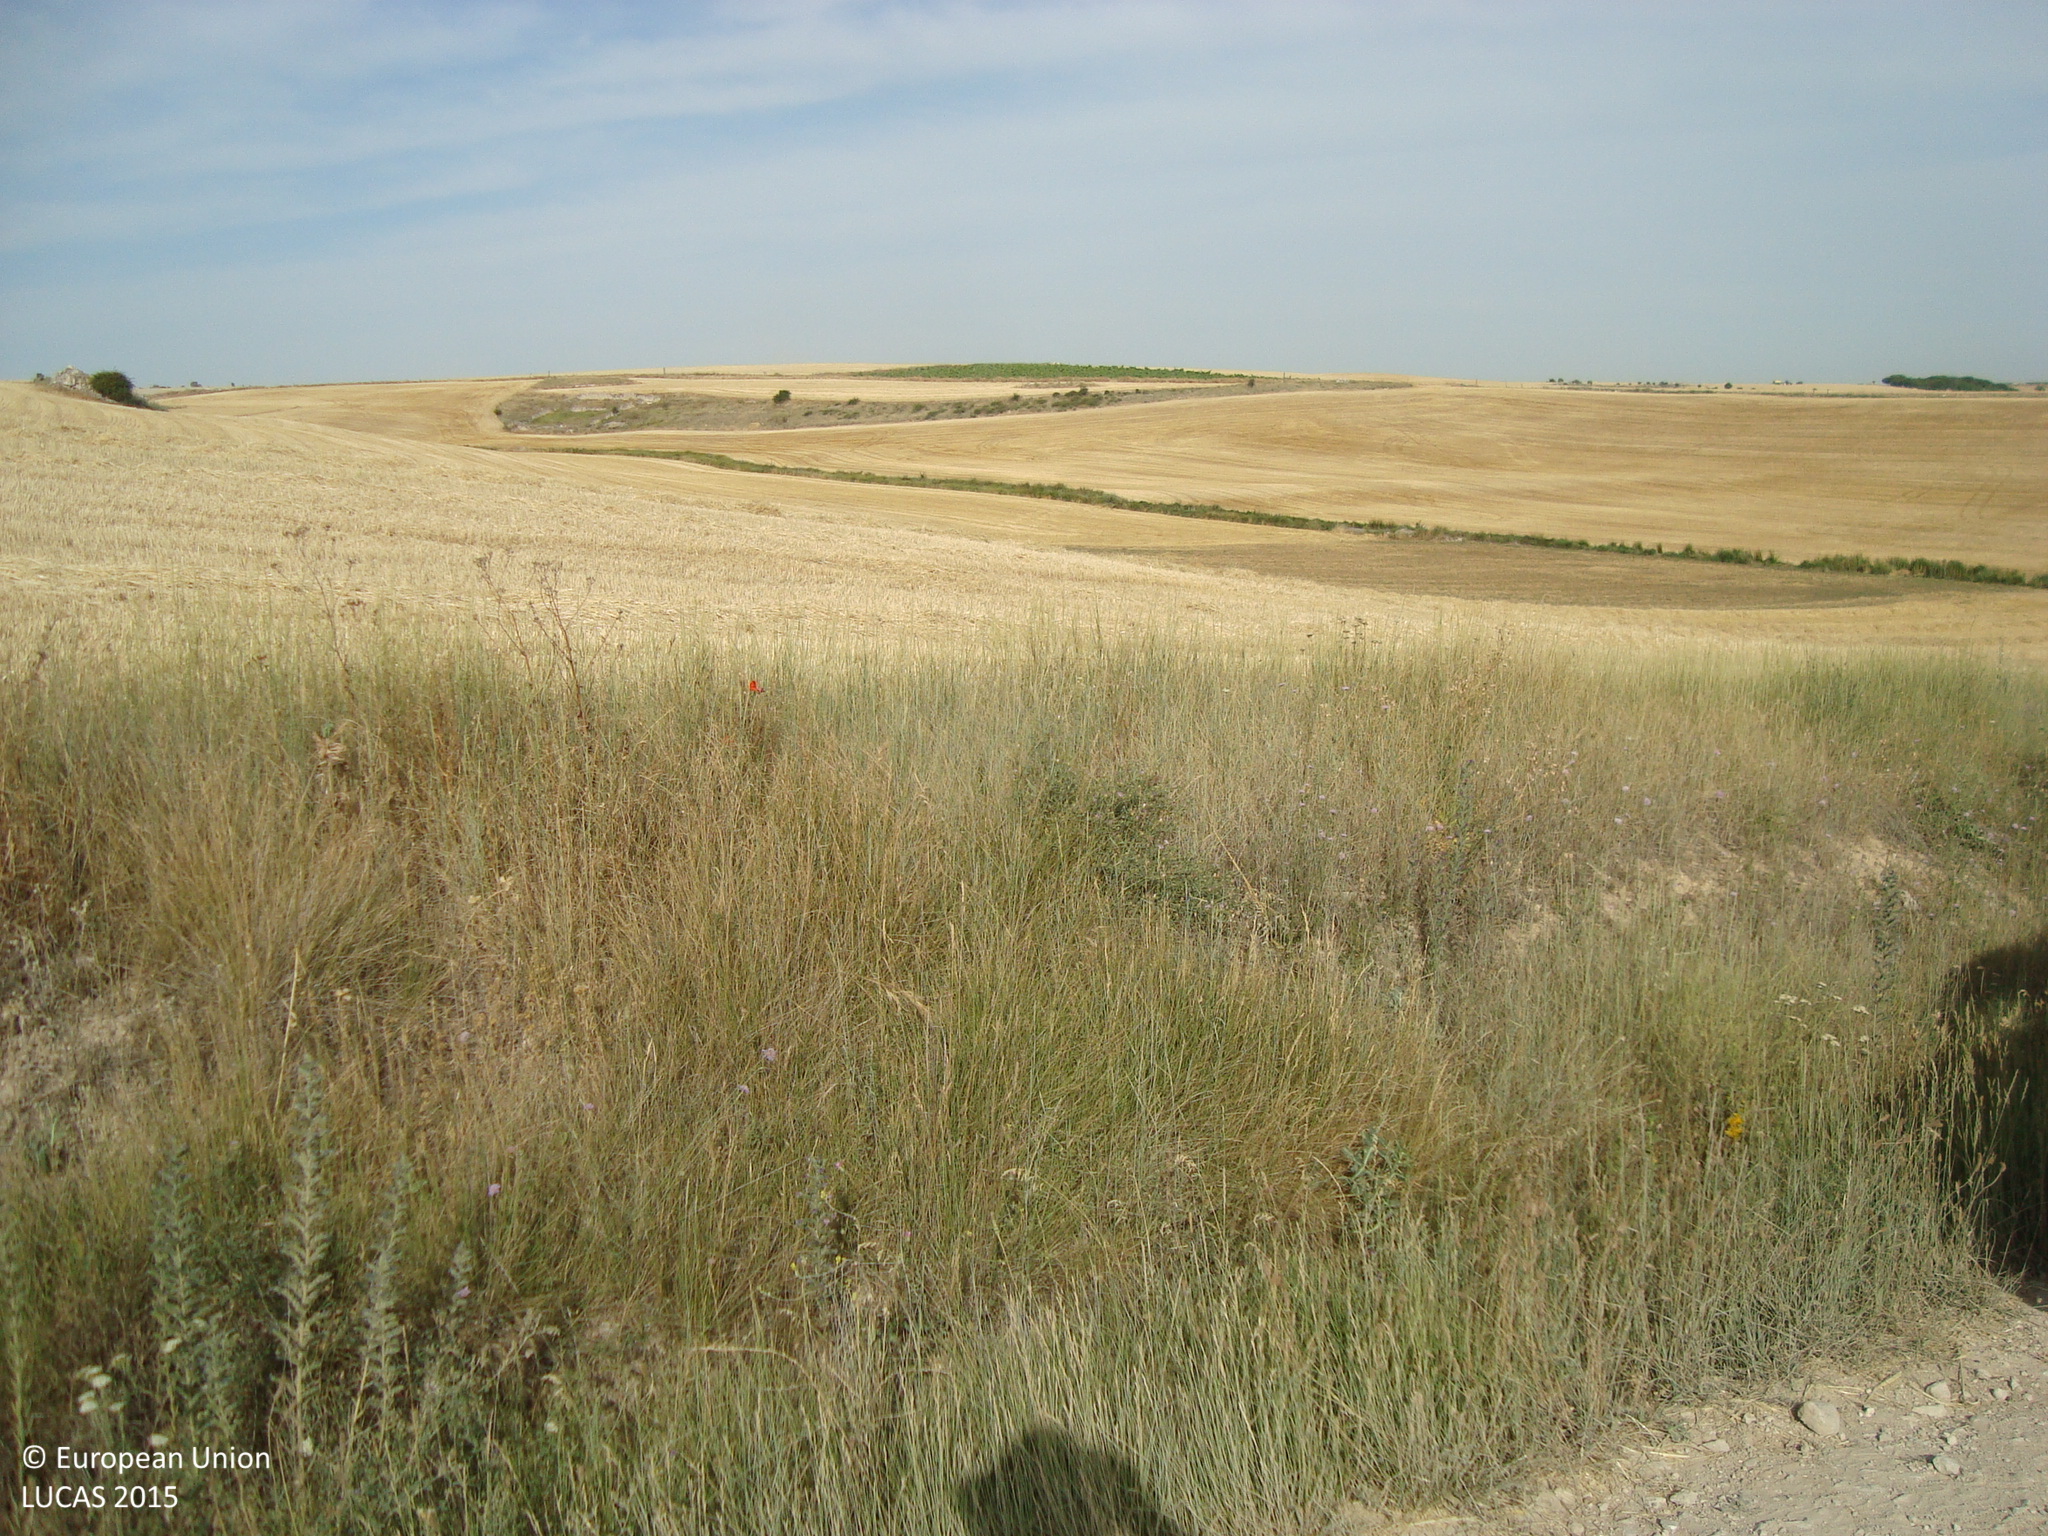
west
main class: Cropland
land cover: Vineyards
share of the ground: 50 - 75 %
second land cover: Other bare soil
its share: > 75 %
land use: Agriculture (excluding fallow land and kitchen gardens)
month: July
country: ES
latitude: 41.7341
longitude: -4.2369
